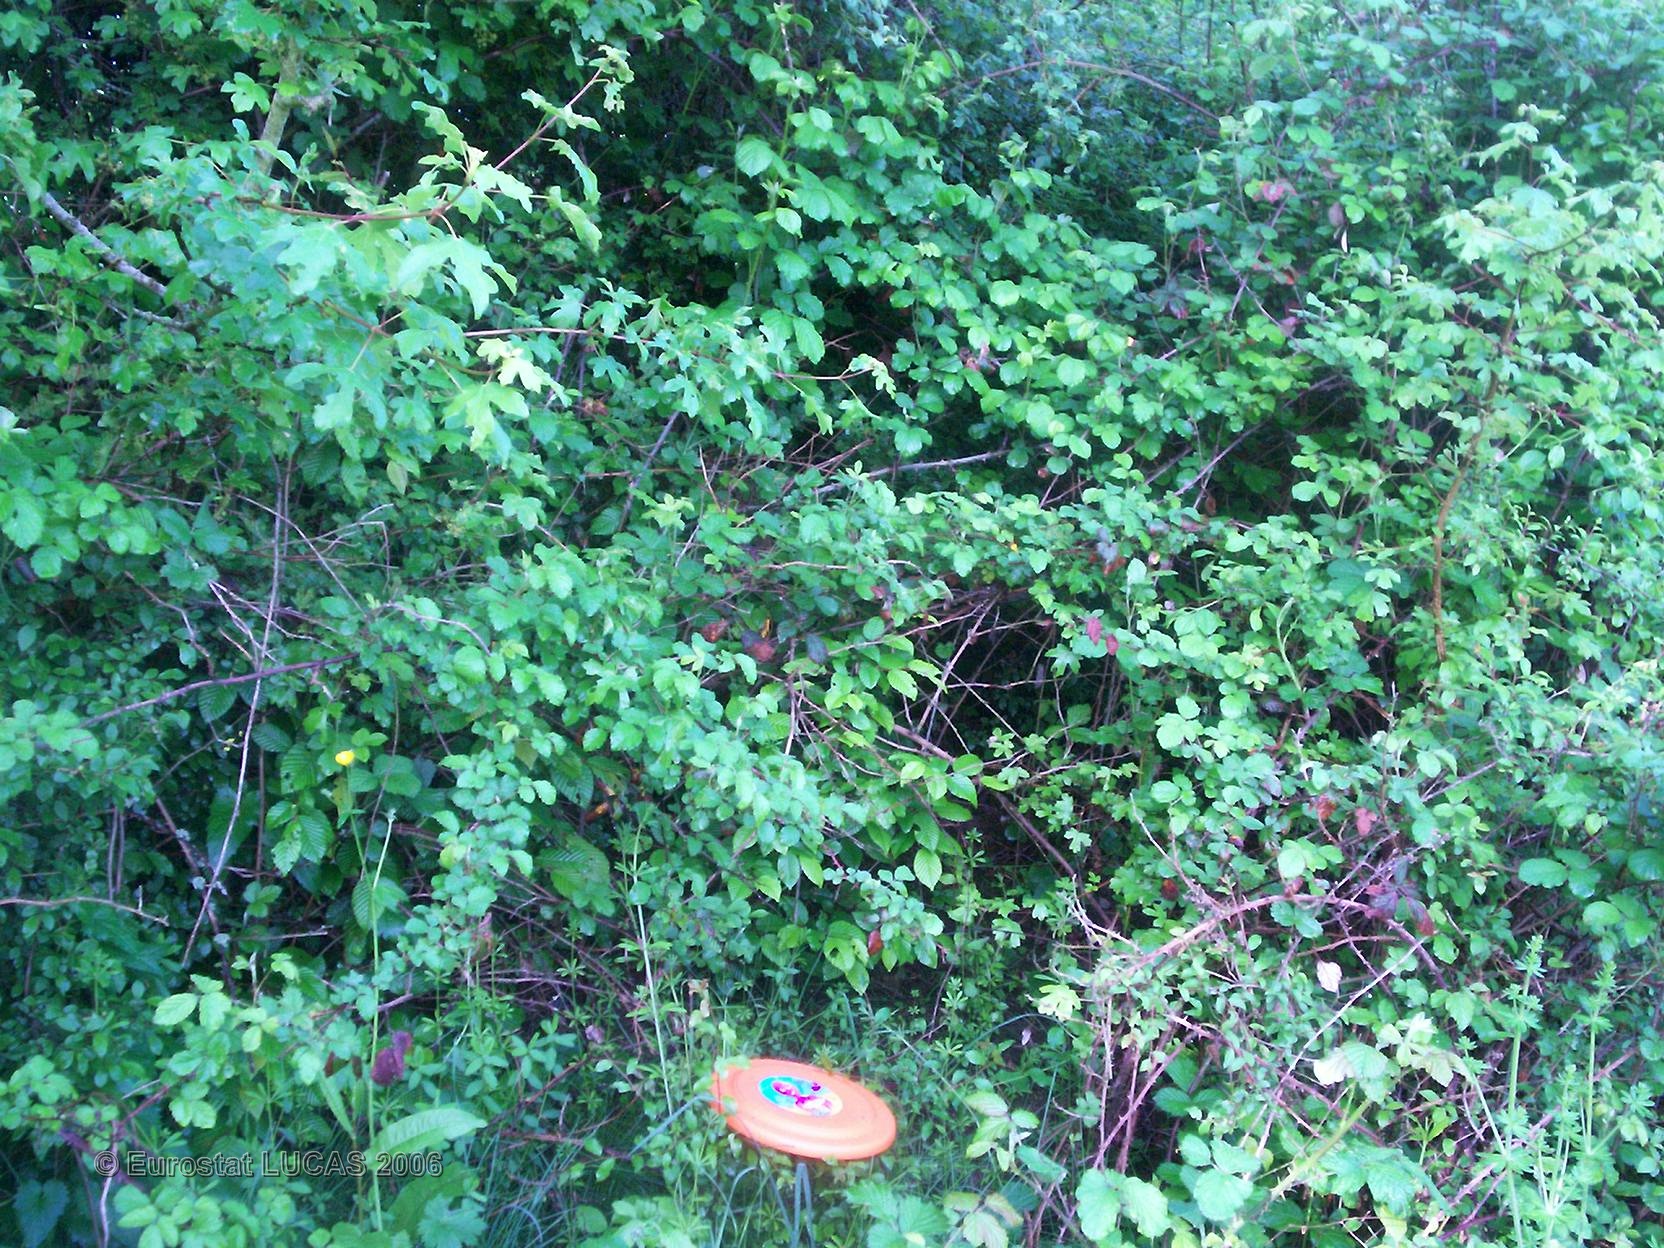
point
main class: Grassland
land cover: Grassland without tree/shrub cover
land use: Agriculture (excluding fallow land and kitchen gardens)
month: May
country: FR
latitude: 46.7214
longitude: 4.6238
